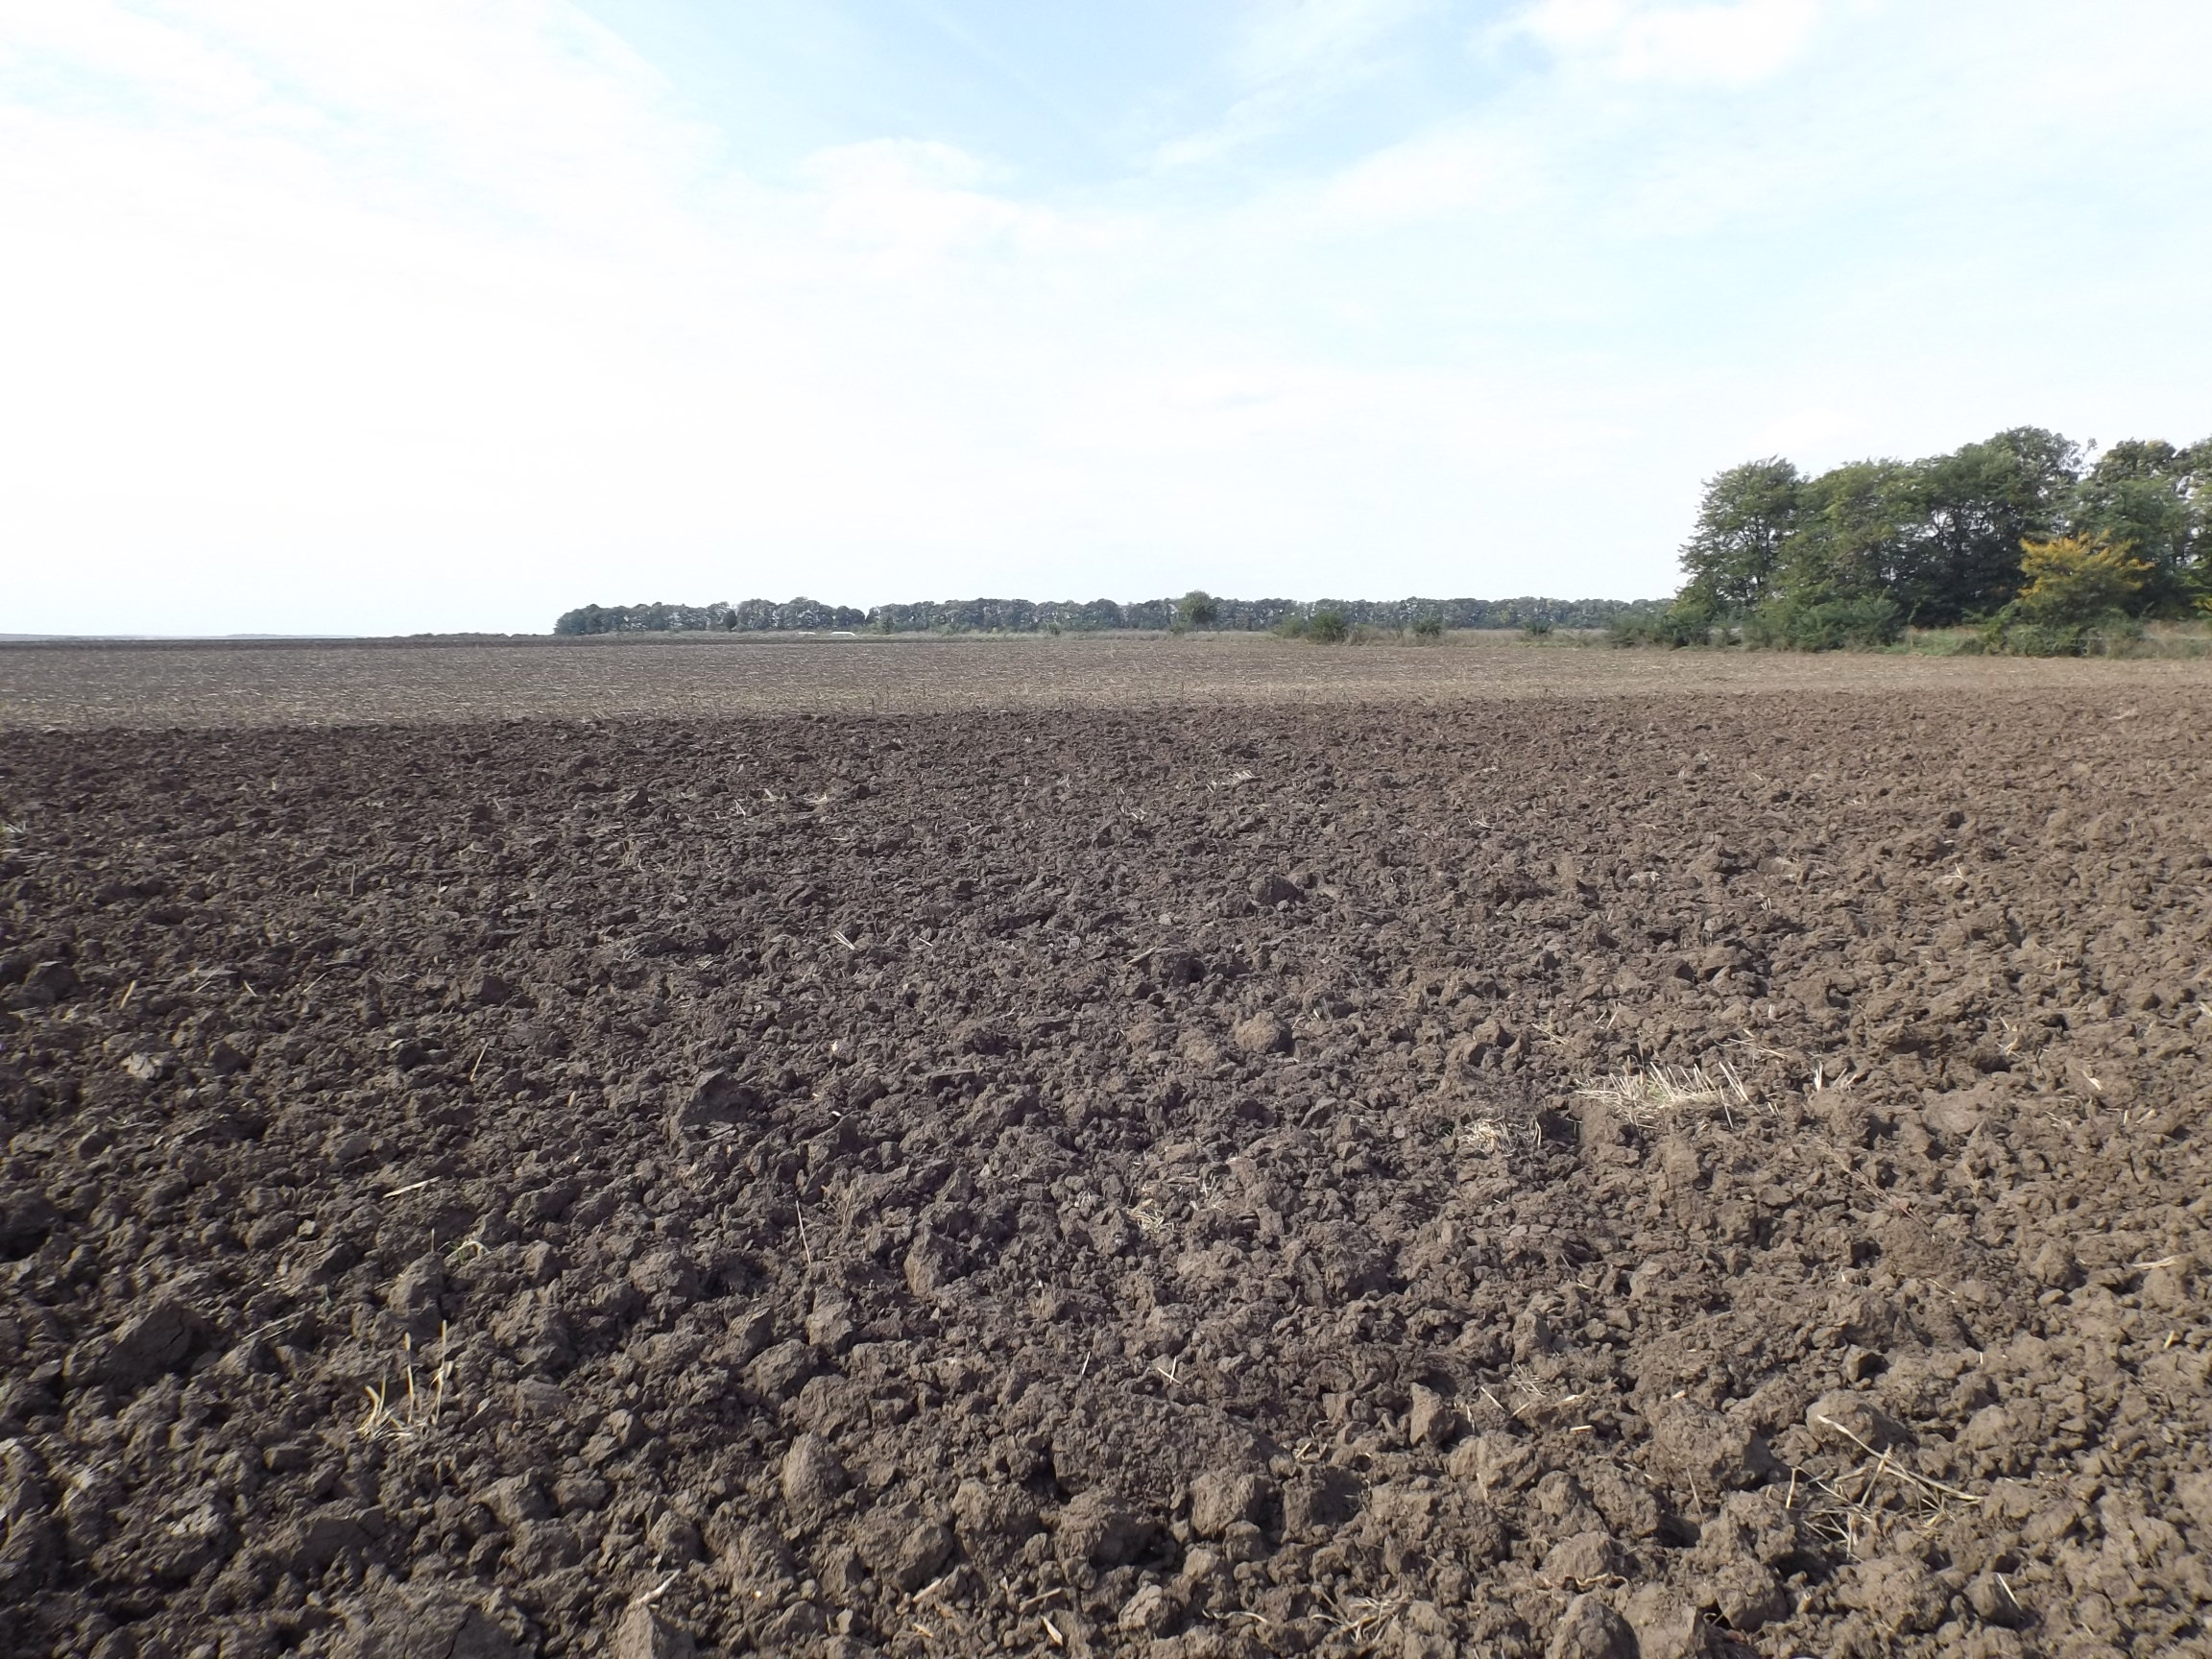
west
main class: Cropland
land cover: Common wheat
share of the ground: < 10 %
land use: Agriculture (excluding fallow land and kitchen gardens)
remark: Harvested field
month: October
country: BG
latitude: 43.9046
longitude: 26.8140
